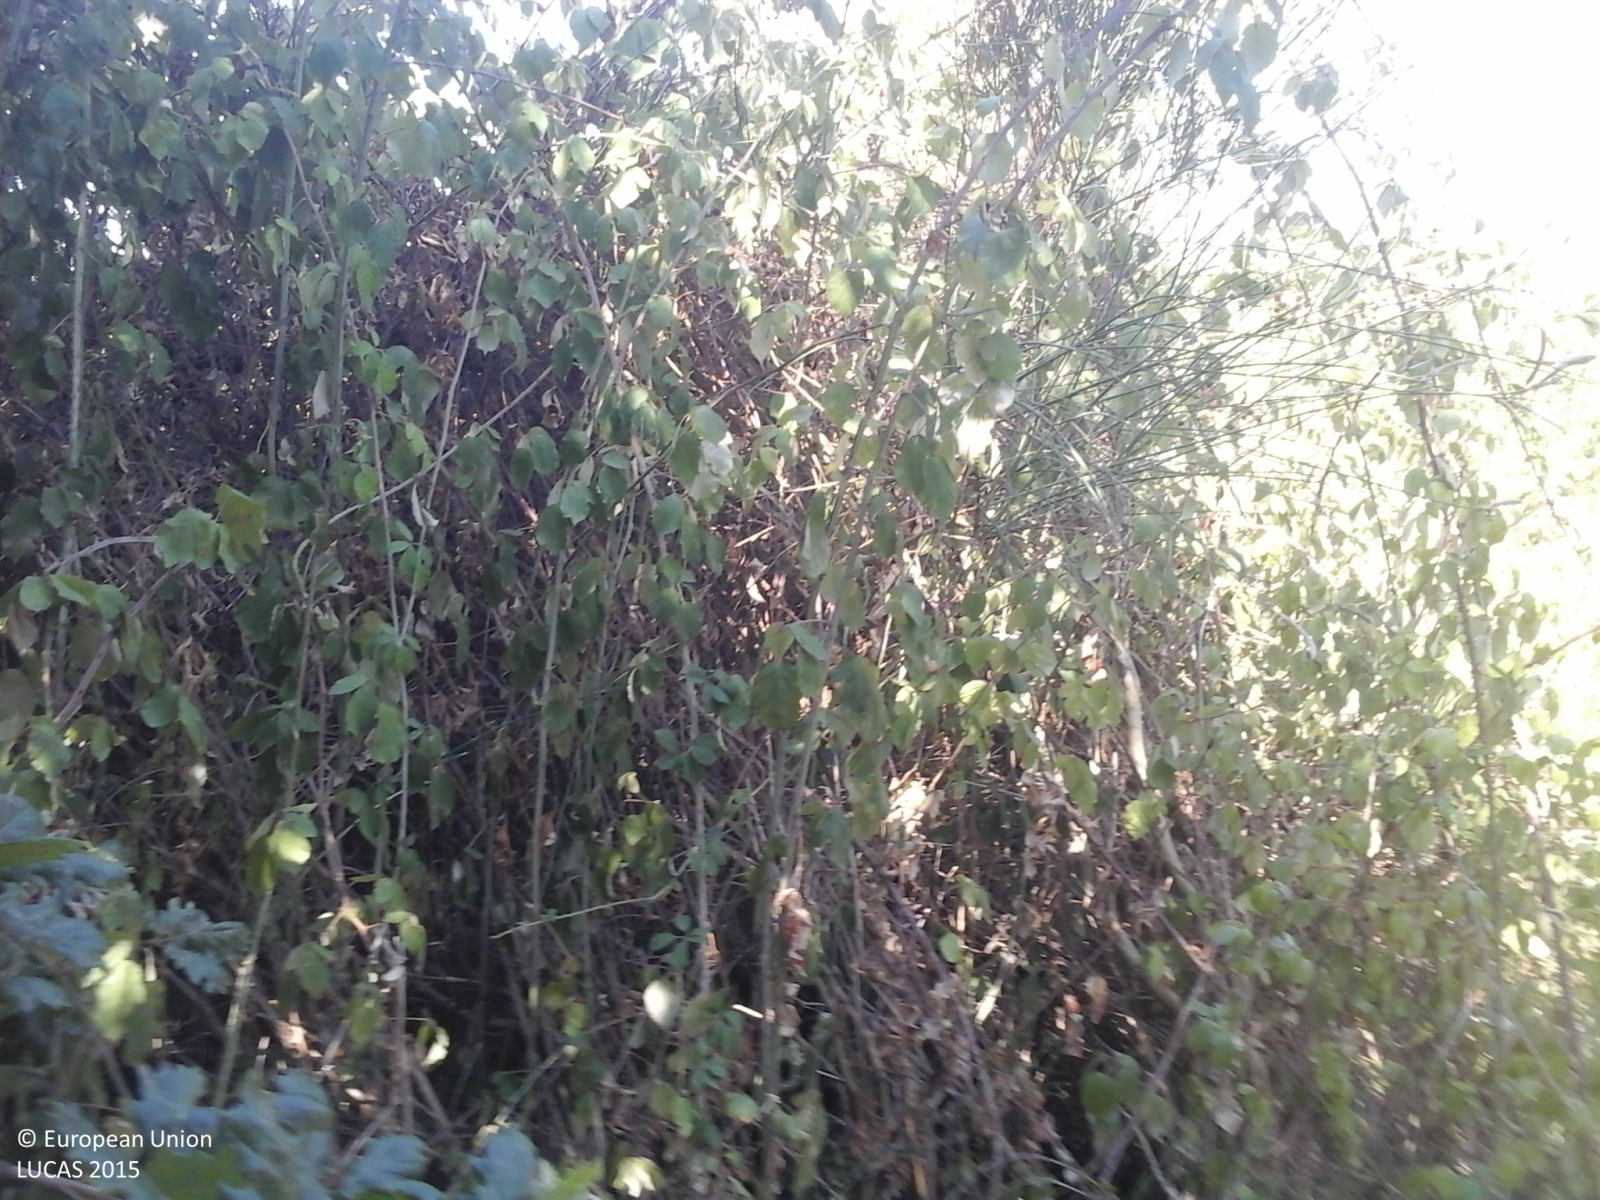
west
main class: Shrubland
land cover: Shrubland without tree cover
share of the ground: > 75 %
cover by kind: shrubs 100 %
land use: Abandoned areas
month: August
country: IT
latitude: 43.8978
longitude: 10.6085
